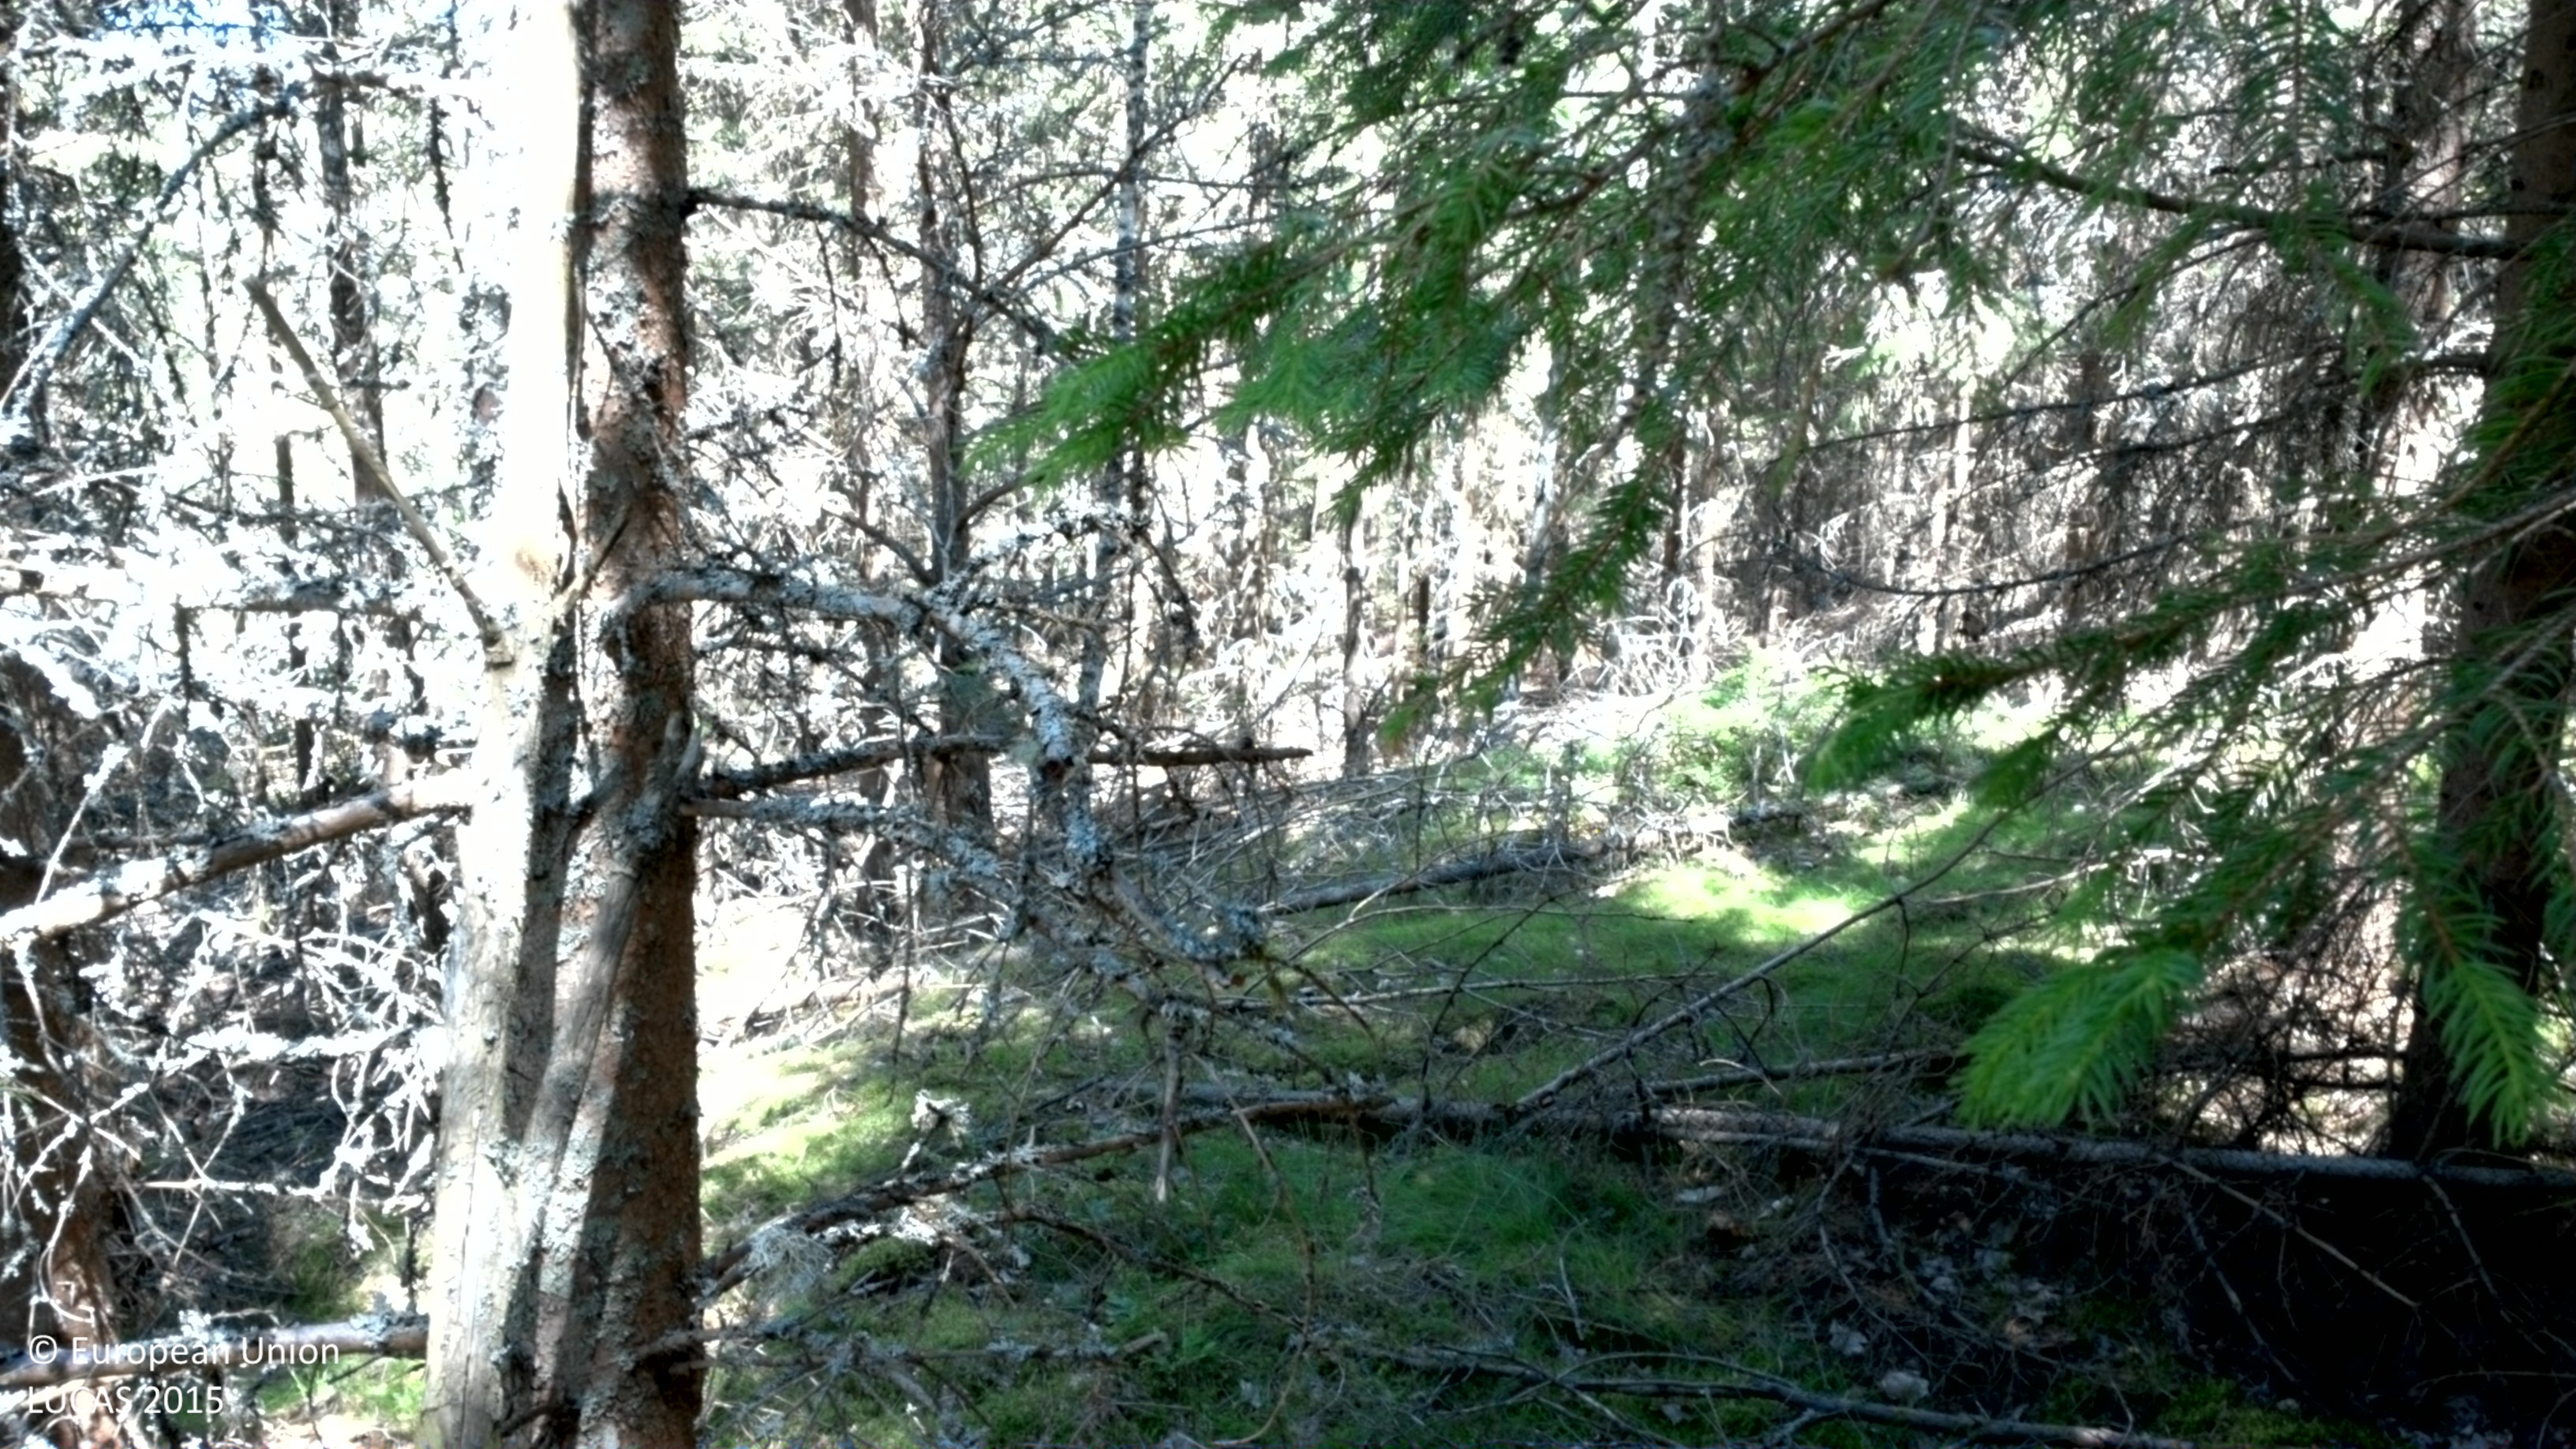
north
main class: Woodland
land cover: Spruce dominated coniferous woodland
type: boreal forest
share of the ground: > 75 %
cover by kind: coniferous forest trees 70 %, broadleaved forest trees 15 %, lichens and mosses 10 %, shrubs 5 %
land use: Forestry
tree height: > 5 m
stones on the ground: < 10 %
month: July
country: SE
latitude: 58.1831
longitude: 16.6129
